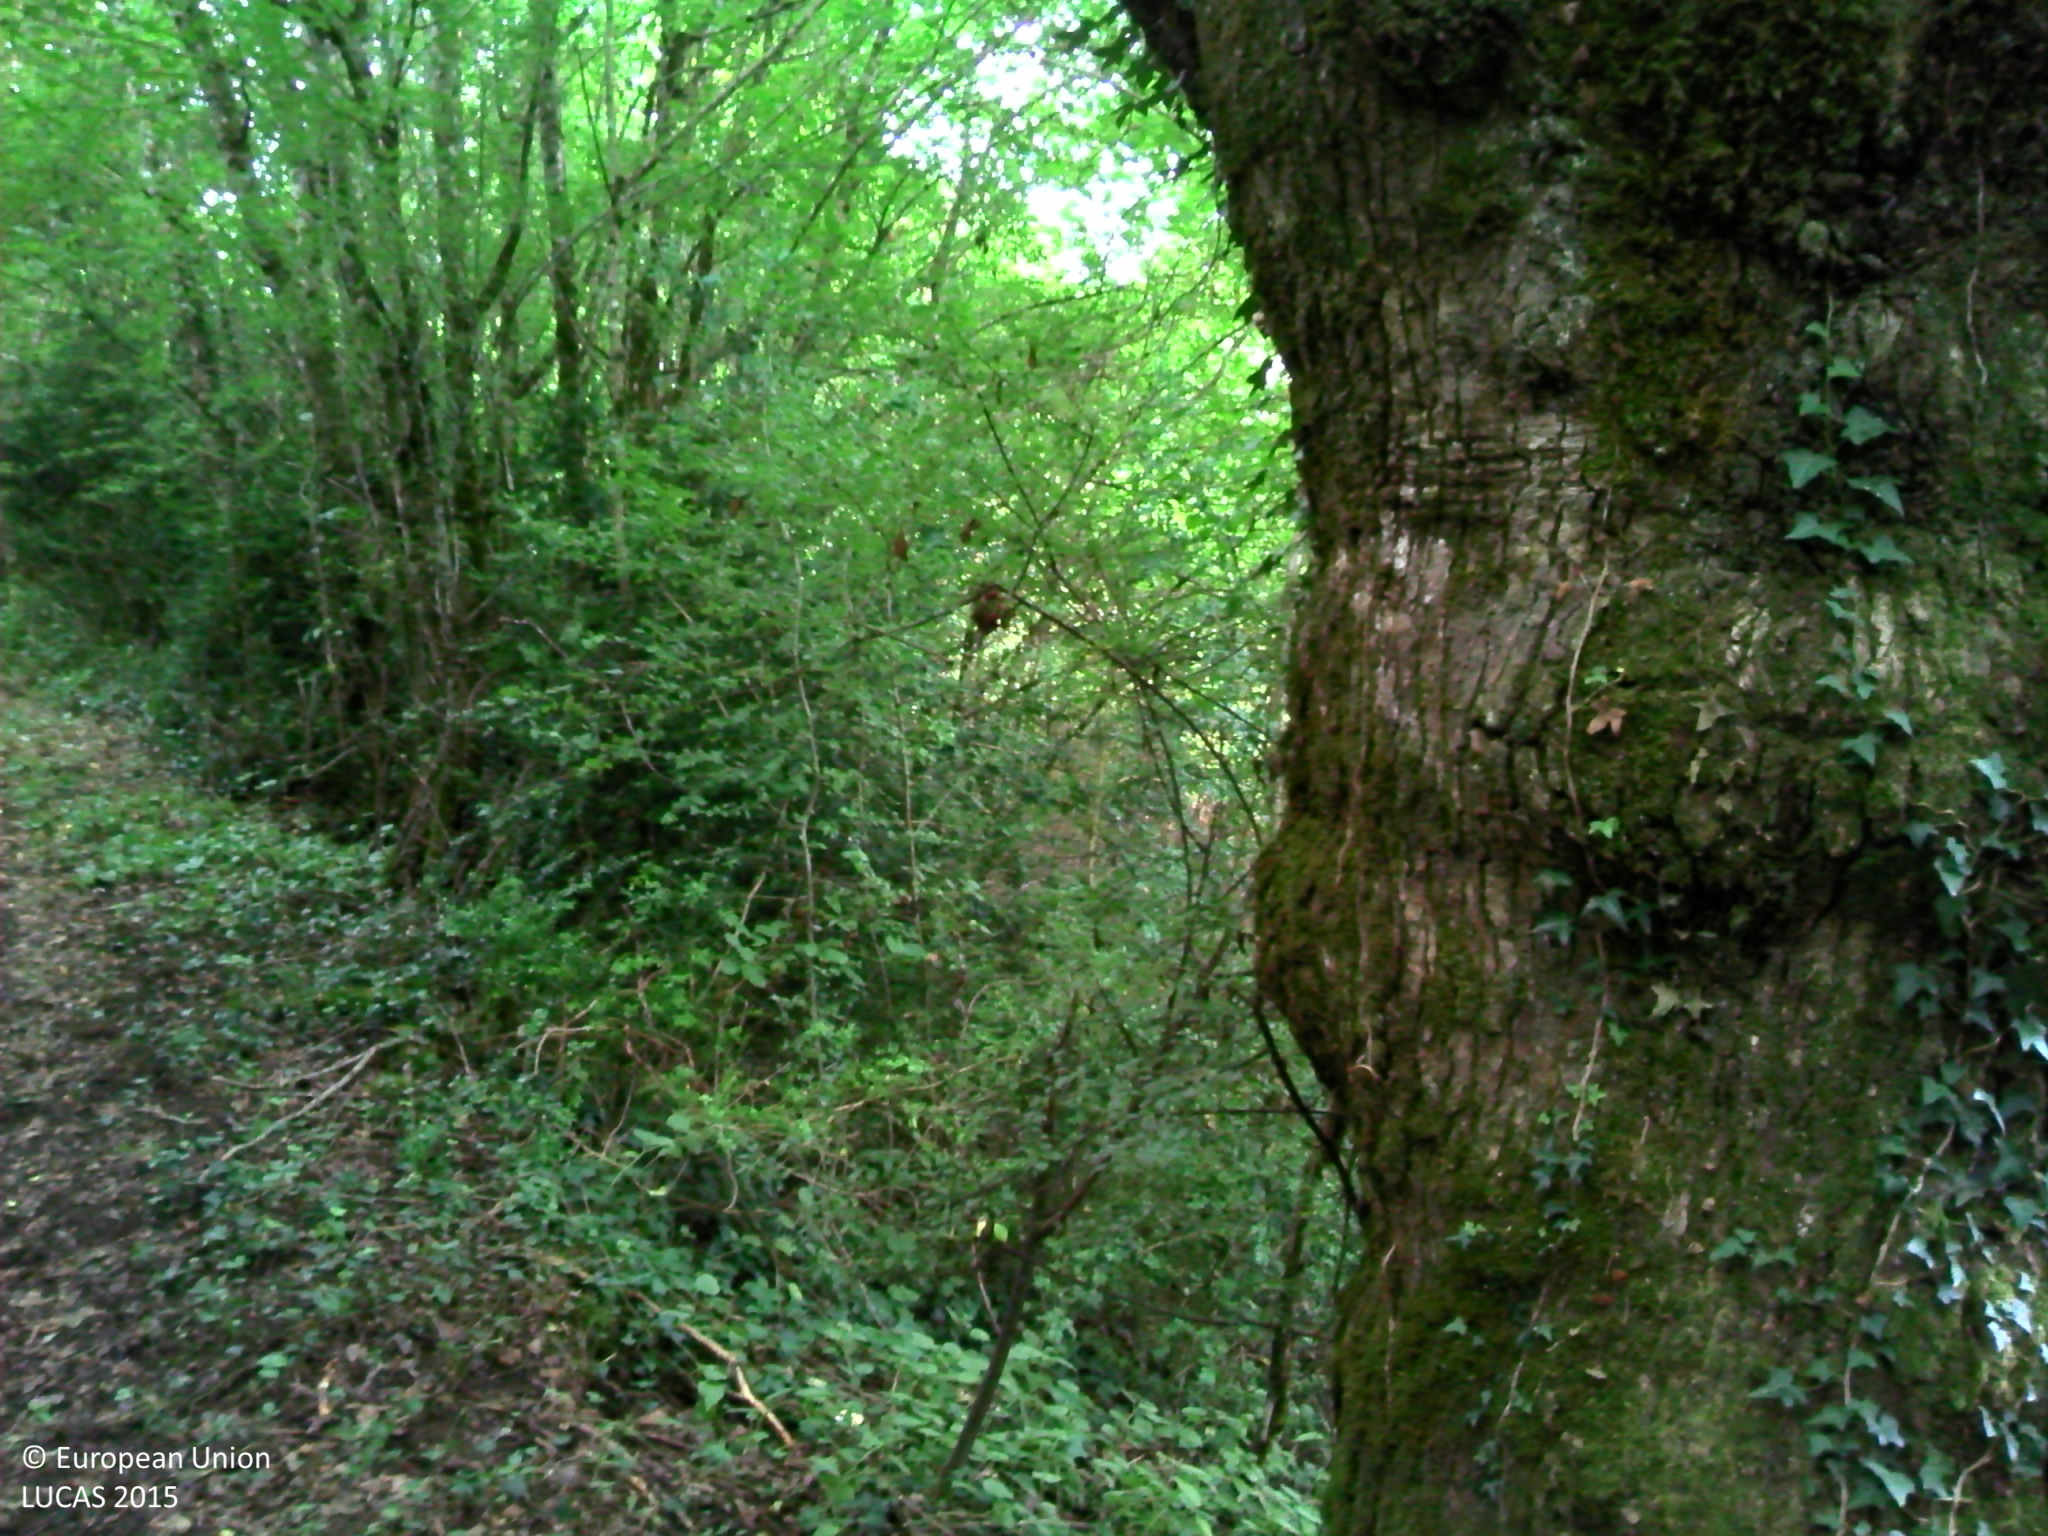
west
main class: Woodland
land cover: Broadleaved woodland
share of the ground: > 75 %
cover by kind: shrubs 60 %, broadleaved forest trees 20 %, herbaceous plants 20 %
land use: Semi-natural and natural areas not in use
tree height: < 5 m
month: August
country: FR
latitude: 46.1509
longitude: 0.3628
